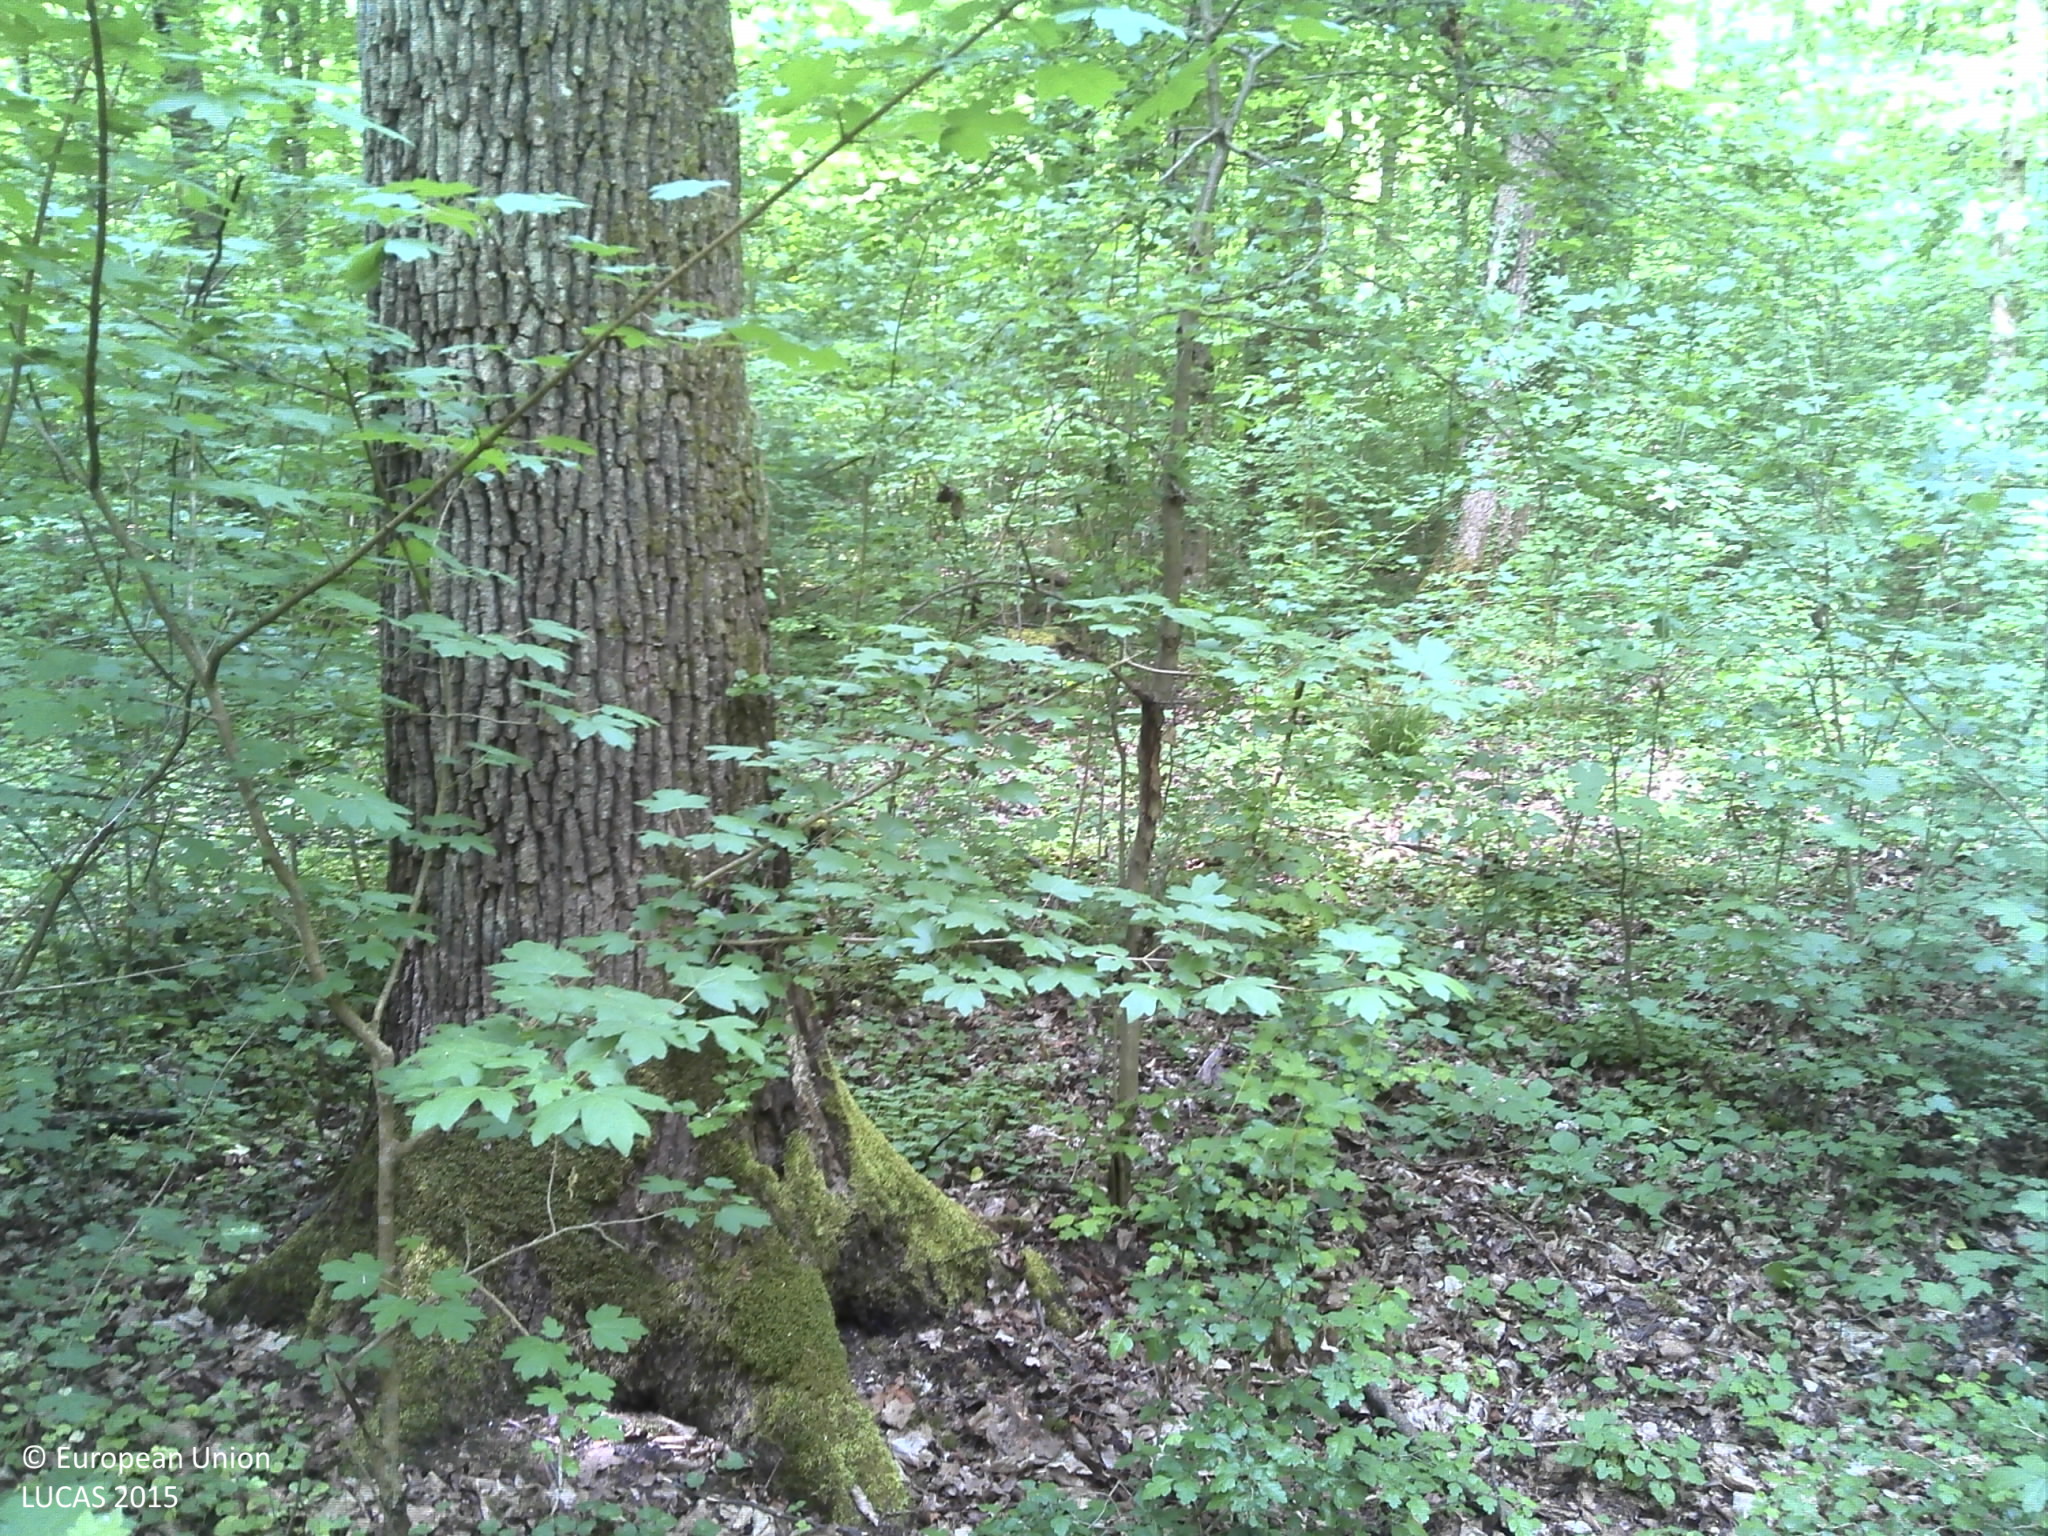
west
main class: Woodland
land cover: Broadleaved woodland
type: mesophytic deciduous forest
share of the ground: > 75 %
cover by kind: broadleaved forest trees 100 %
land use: Forestry
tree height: > 5 m
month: April
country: HR
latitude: 45.0969
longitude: 18.8381
